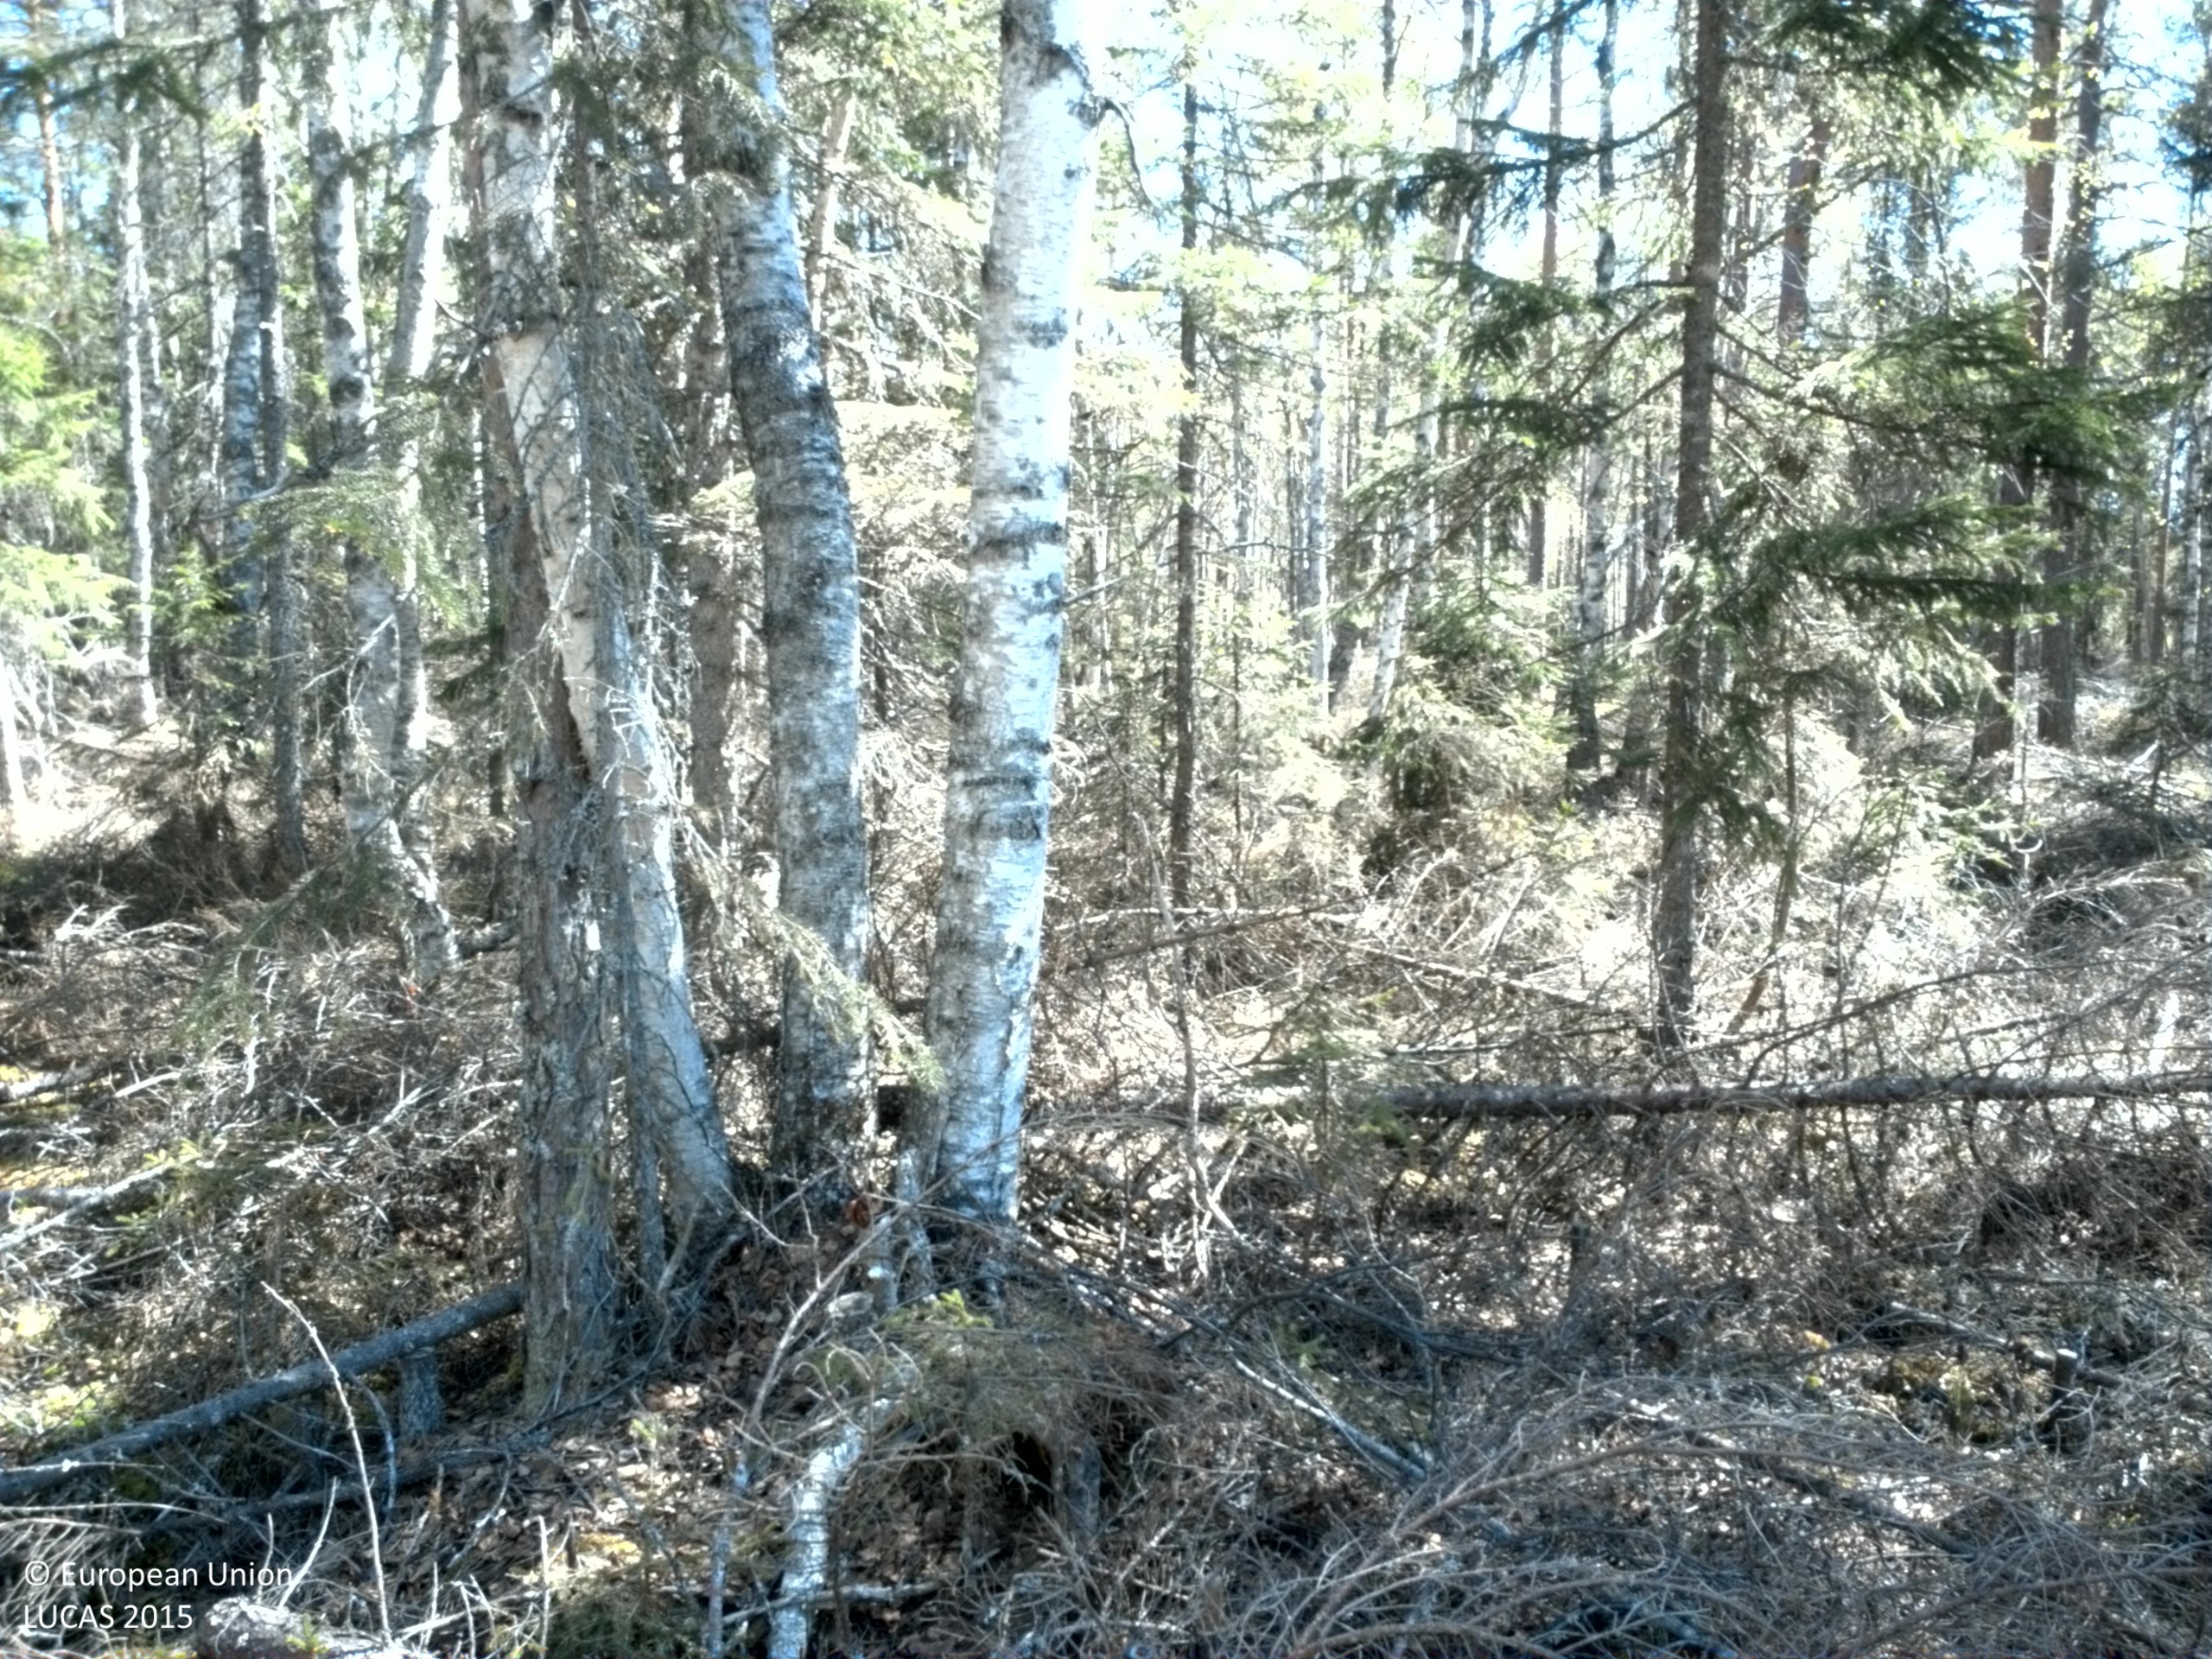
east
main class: Woodland
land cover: Spruce dominated mixed woodland
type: boreal forest
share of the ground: 10 - 25 %
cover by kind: shrubs 20 %, unconsolidated bare surface 20 %, lichens and mosses 15 %, broadleaved forest trees 10 %, coniferous forest trees 5 %
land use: Forestry
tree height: > 5 m
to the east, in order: Spruce dominated mixed woodland; Broadleaved woodland; Pine dominated mixed woodland; Pine dominated coniferous woodland; Spruce dominated mixed woodland; Other mixed woodland; Broadleaved woodland; Paved roads, cycling and walking lanes; Broadleaved woodland
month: May
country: SE
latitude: 63.0690
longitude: 18.0324
